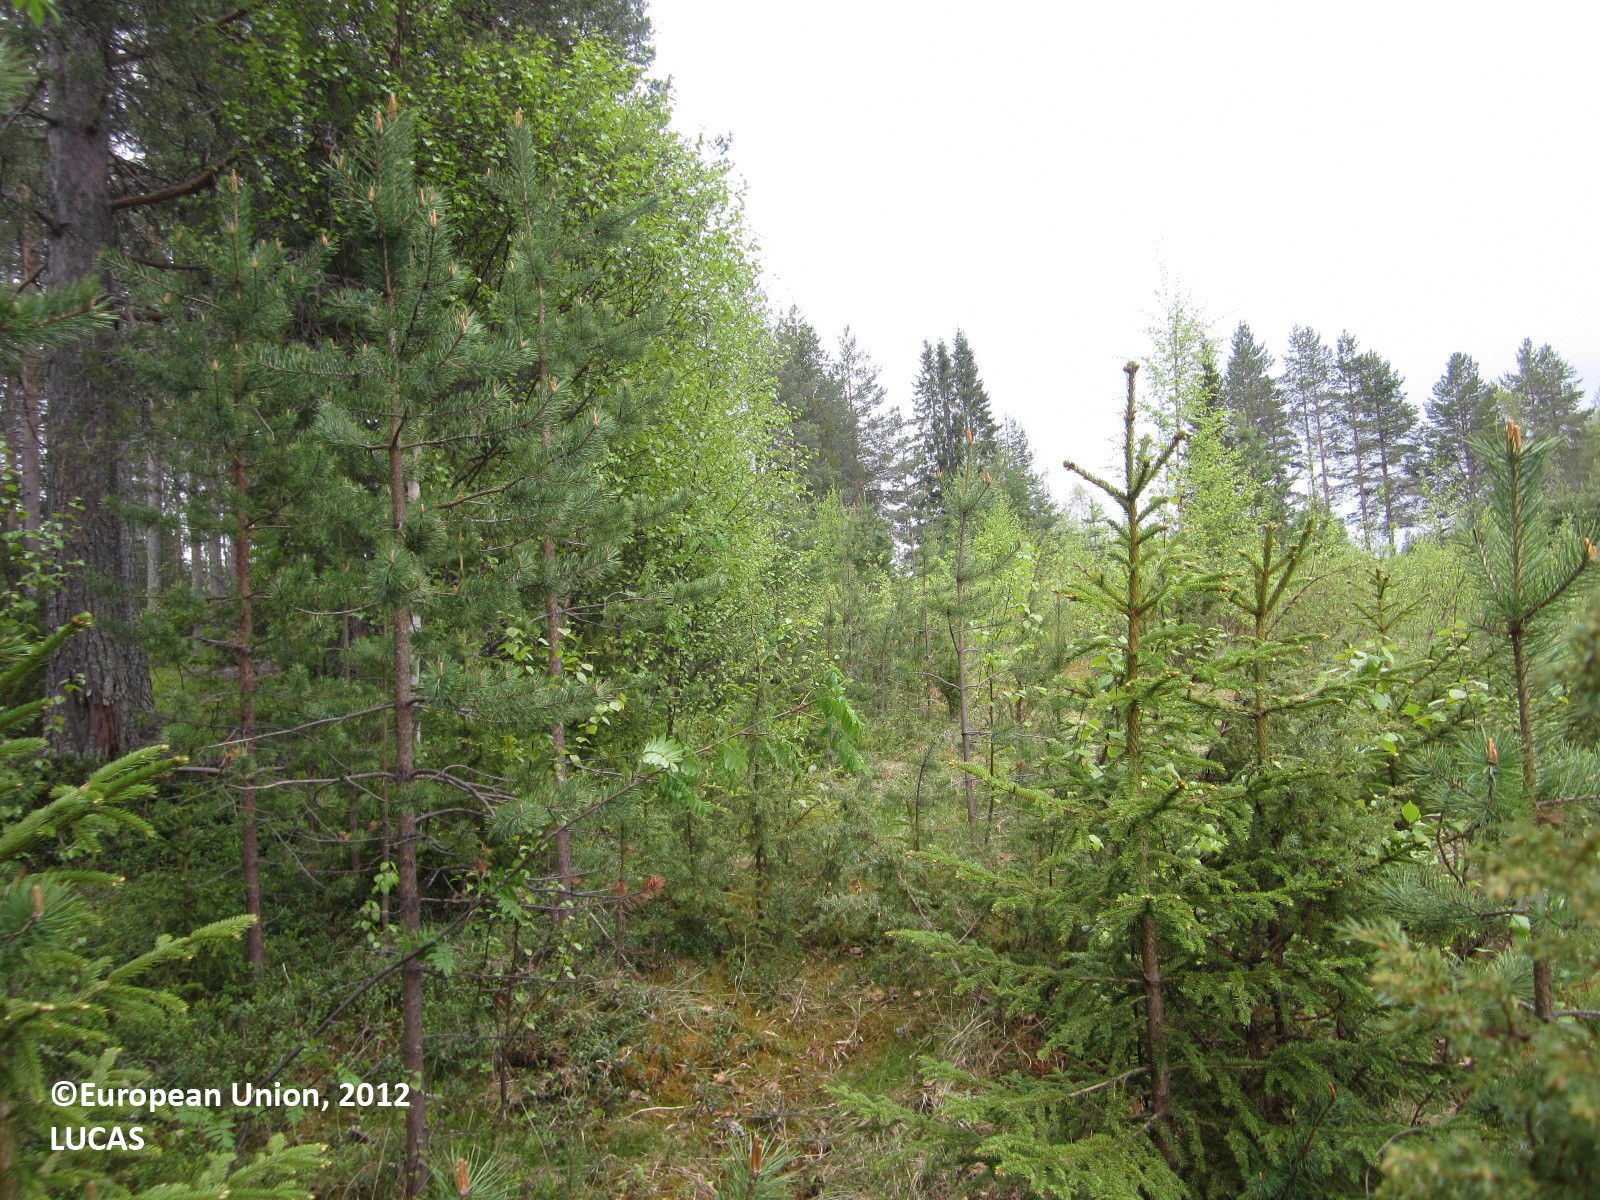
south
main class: Woodland
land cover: Pine dominated mixed woodland
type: boreal forest
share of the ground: > 75 %
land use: Forestry
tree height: > 5 m
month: June
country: FI
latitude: 64.7728
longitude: 28.7926
